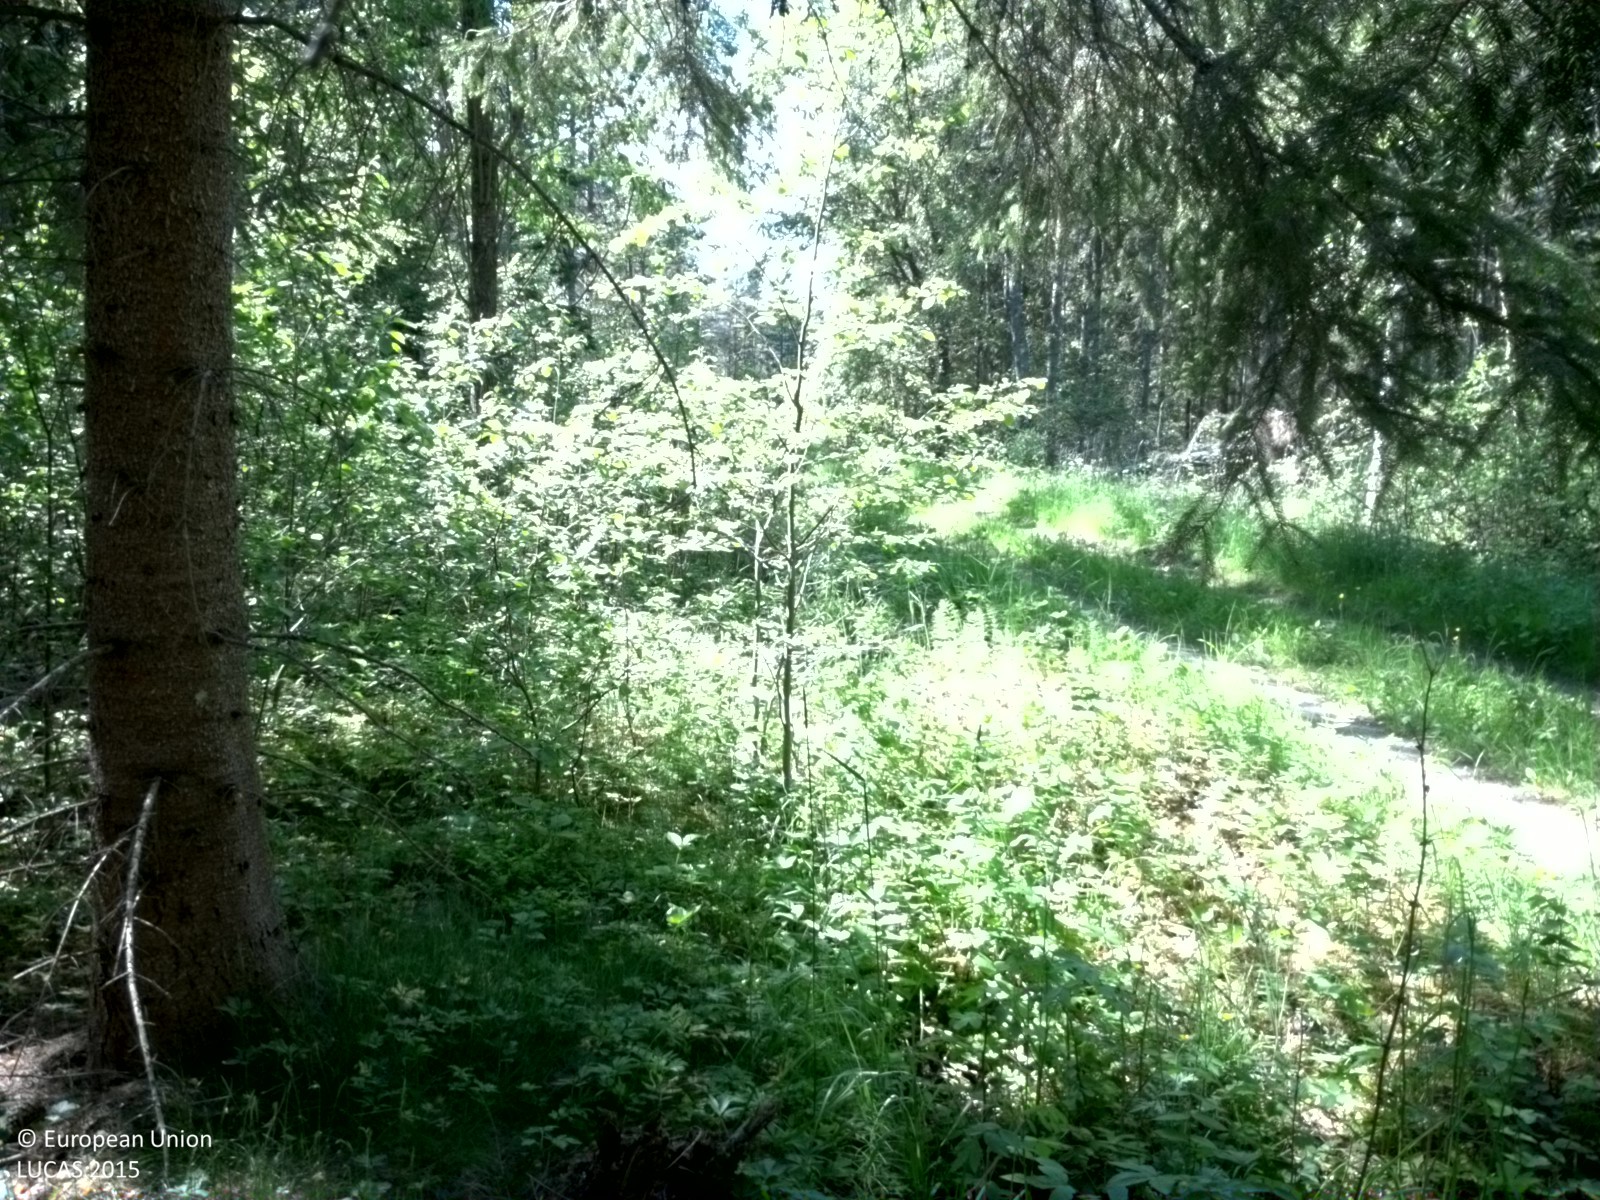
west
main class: Woodland
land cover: Spruce dominated coniferous woodland
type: boreal forest
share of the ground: 50 - 75 %
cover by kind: coniferous forest trees 50 %, herbaceous plants 30 %, broadleaved forest trees 10 %, shrubs 10 %
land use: Forestry
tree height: > 5 m
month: June
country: SE
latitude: 60.1897
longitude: 17.6571
